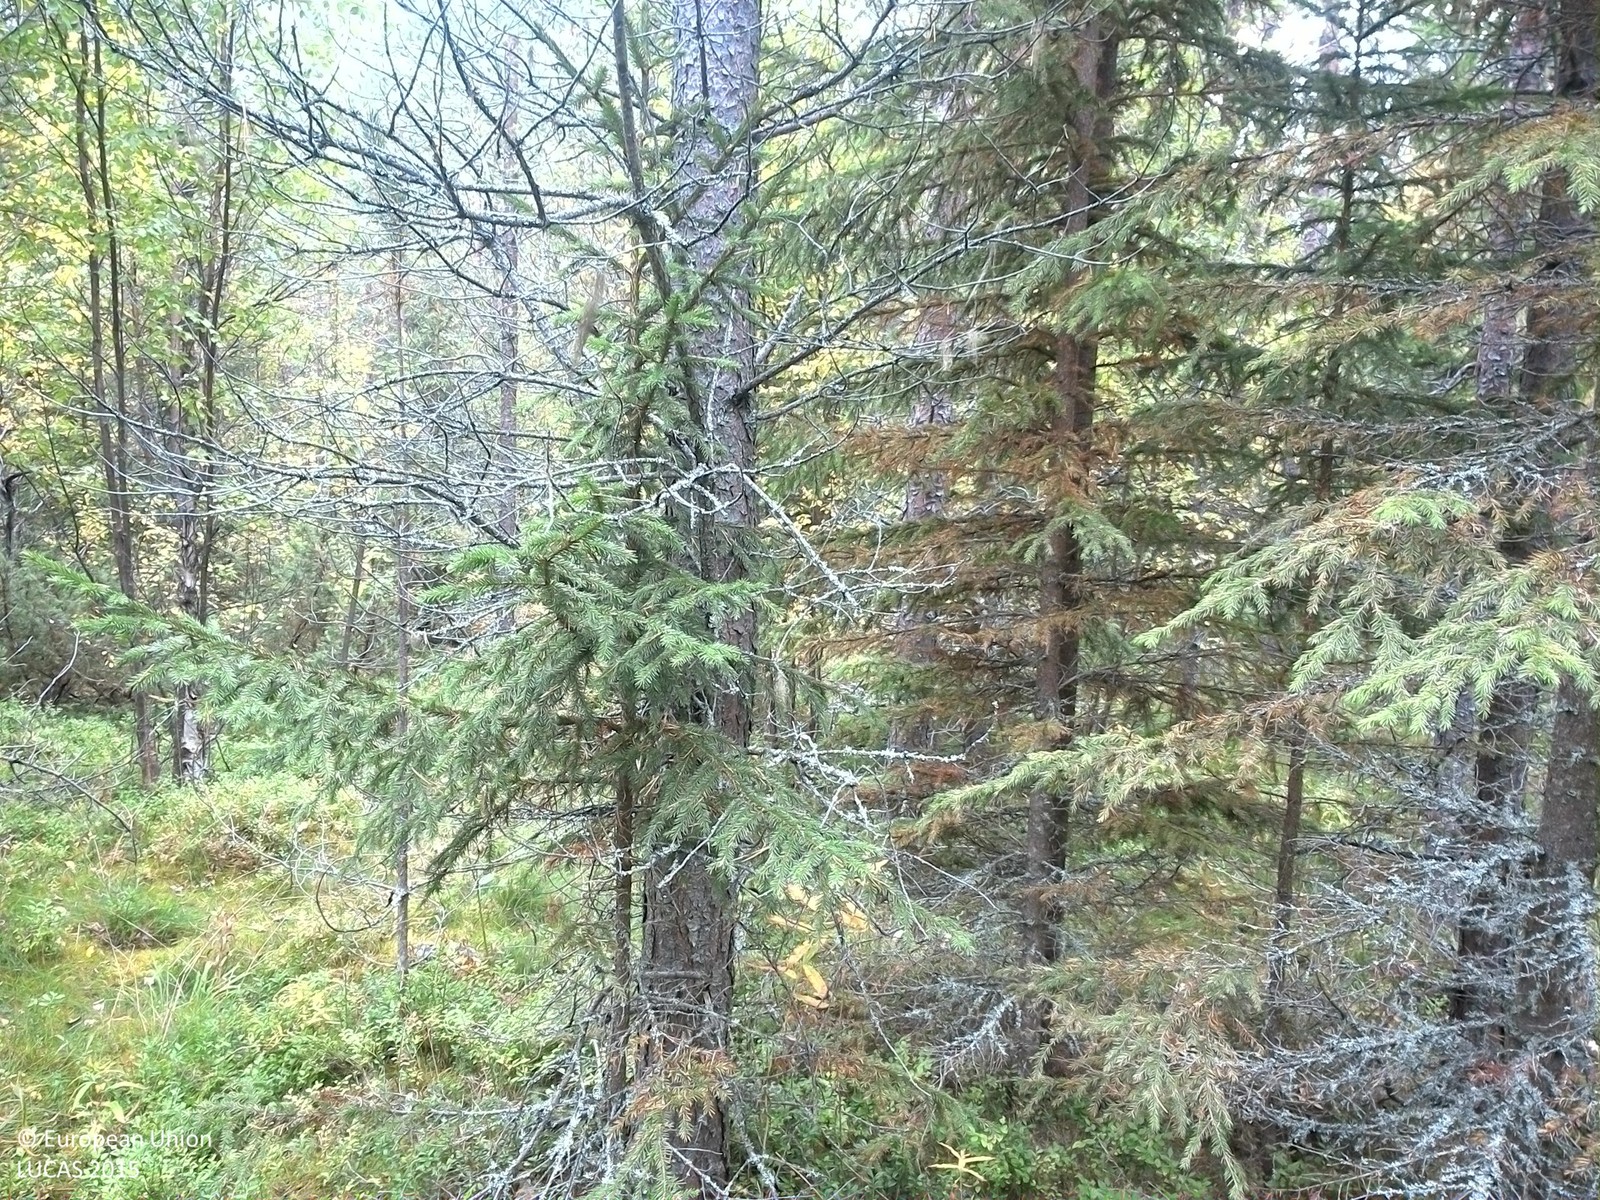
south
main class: Woodland
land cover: Pine dominated mixed woodland
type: boreal forest
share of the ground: 50 - 75 %
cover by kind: coniferous forest trees 45 %, shrubs 25 %, broadleaved forest trees 15 %, lichens and mosses 10 %, herbaceous plants 5 %
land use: Forestry
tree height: > 5 m
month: September
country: SE
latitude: 63.6067
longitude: 16.2038
